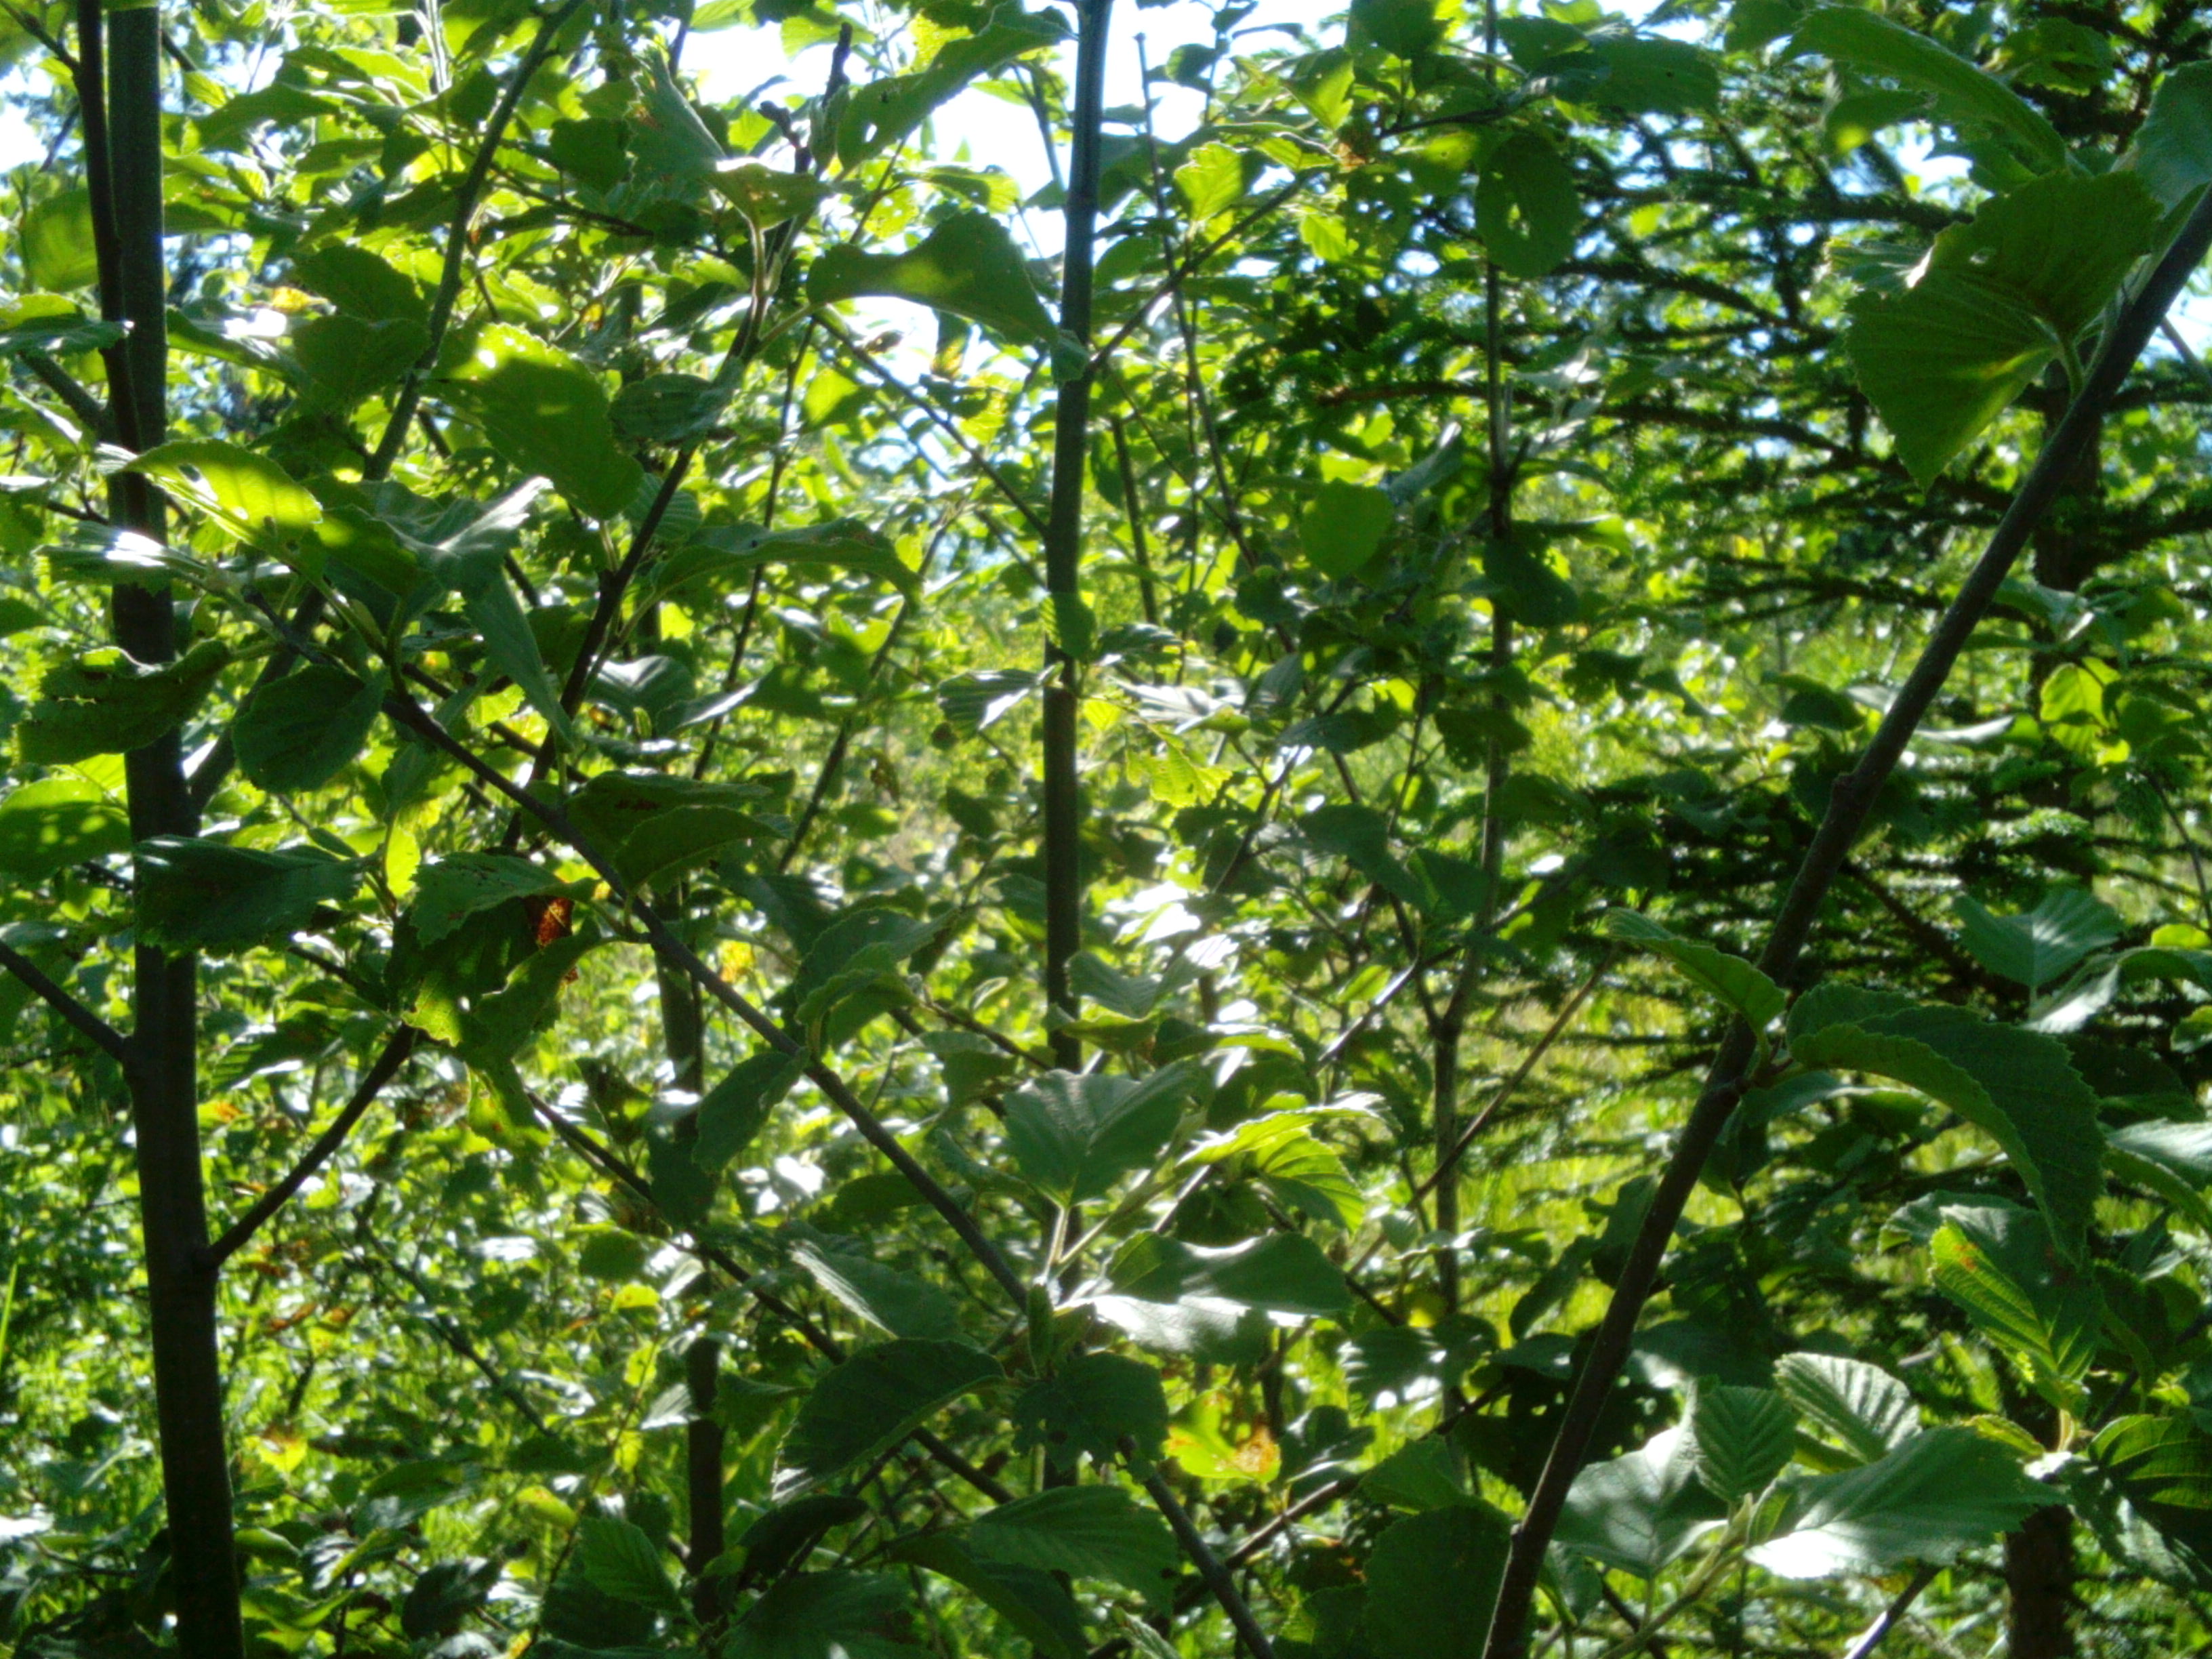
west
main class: Woodland
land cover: Broadleaved woodland
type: non-riverine alder, birch or aspen forest
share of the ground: > 75 %
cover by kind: broadleaved forest trees 75 %, herbaceous plants 15 %, coniferous forest trees 5 %, shrubs 5 %
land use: Forestry
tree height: < 5 m
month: July
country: LV
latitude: 56.4909
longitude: 22.0527
